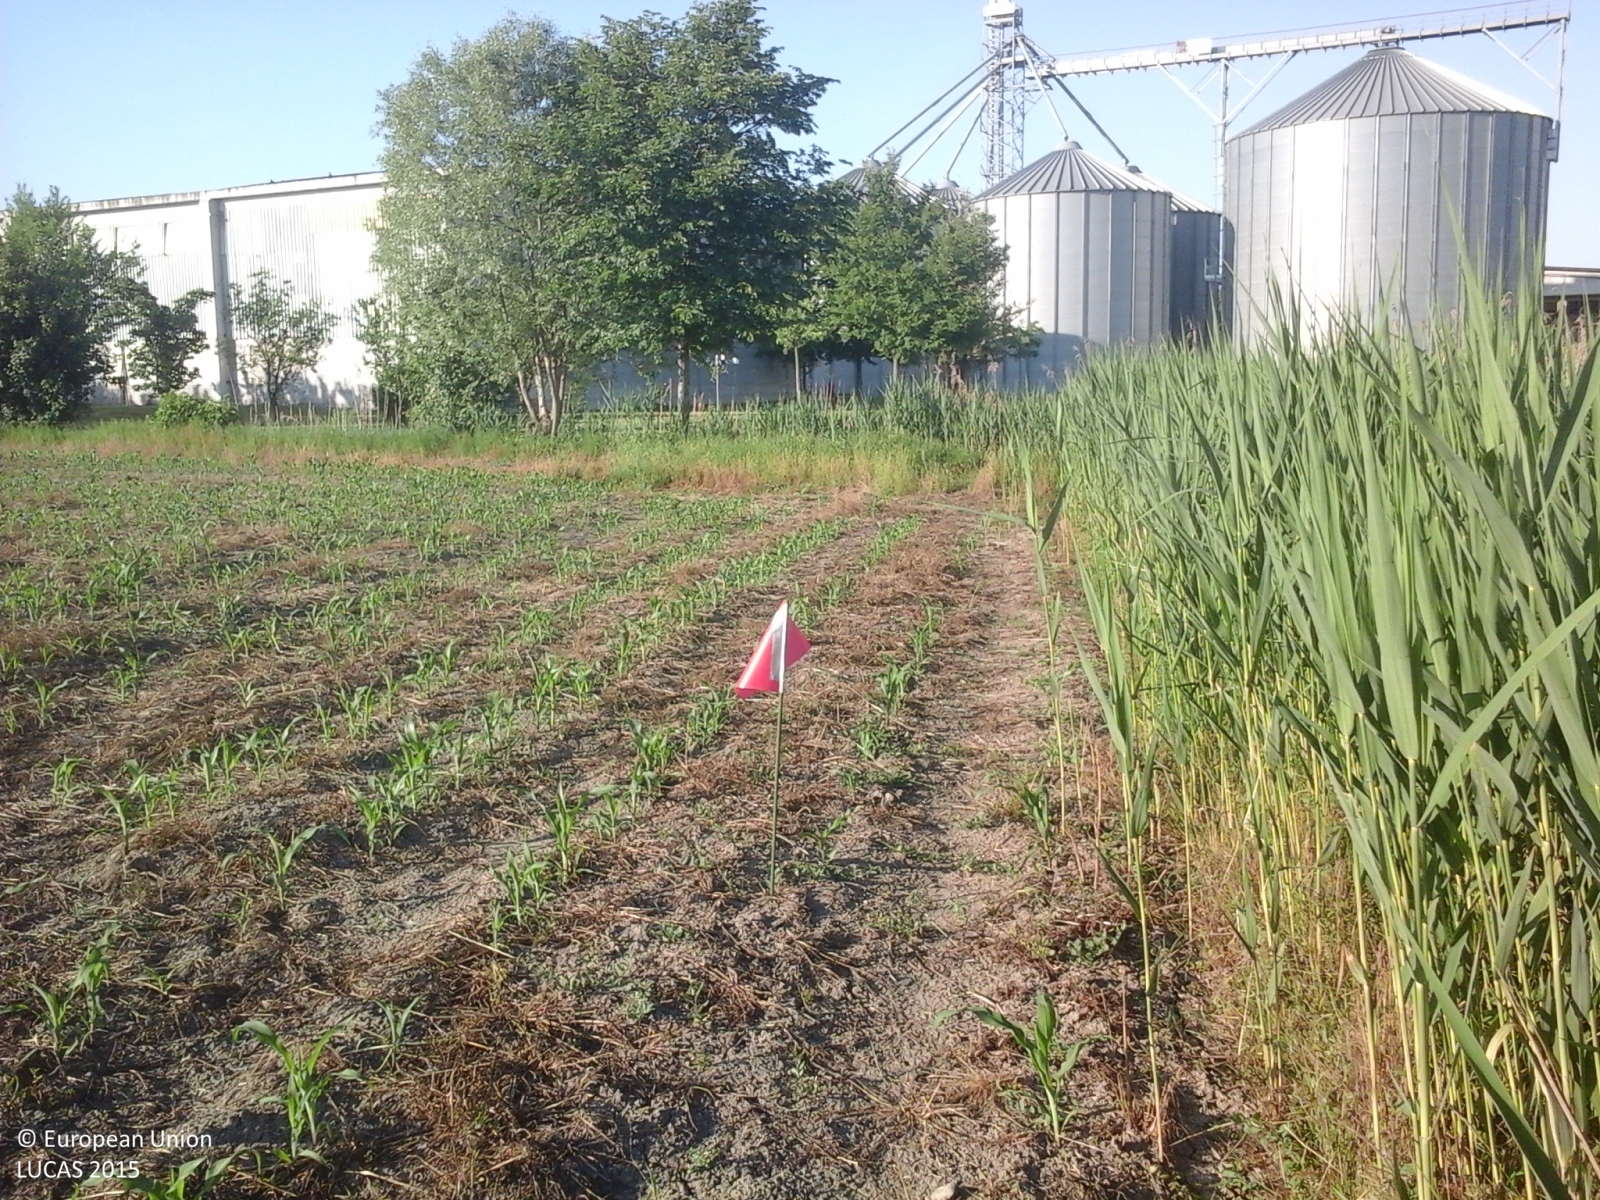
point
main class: Cropland
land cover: Maize
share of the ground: 10 - 25 %
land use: Agriculture (excluding fallow land and kitchen gardens)
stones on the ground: < 10 %
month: May
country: IT
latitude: 44.9591
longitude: 10.9742
